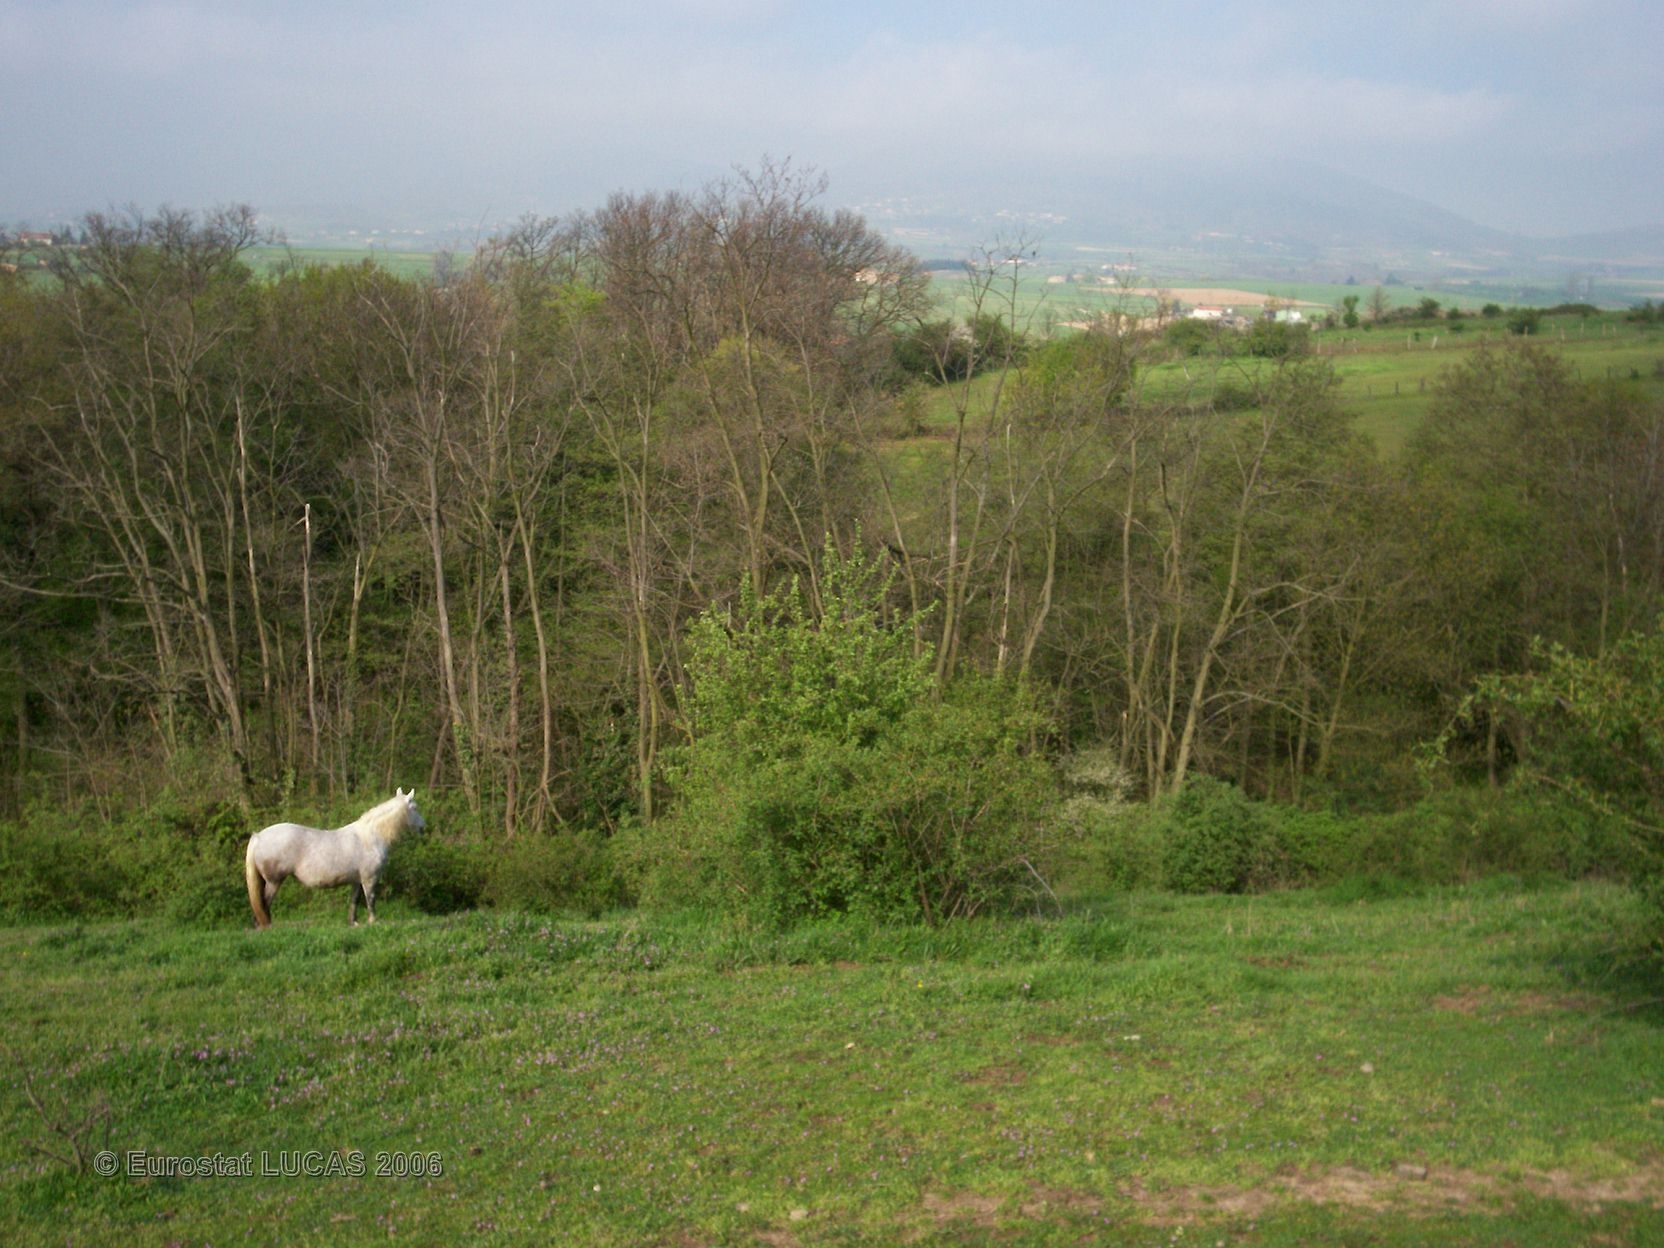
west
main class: Grassland
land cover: Grassland with sparse tree/shrub cover
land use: Agriculture (excluding fallow land and kitchen gardens)
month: April
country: FR
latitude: 45.4832
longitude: 4.7715
